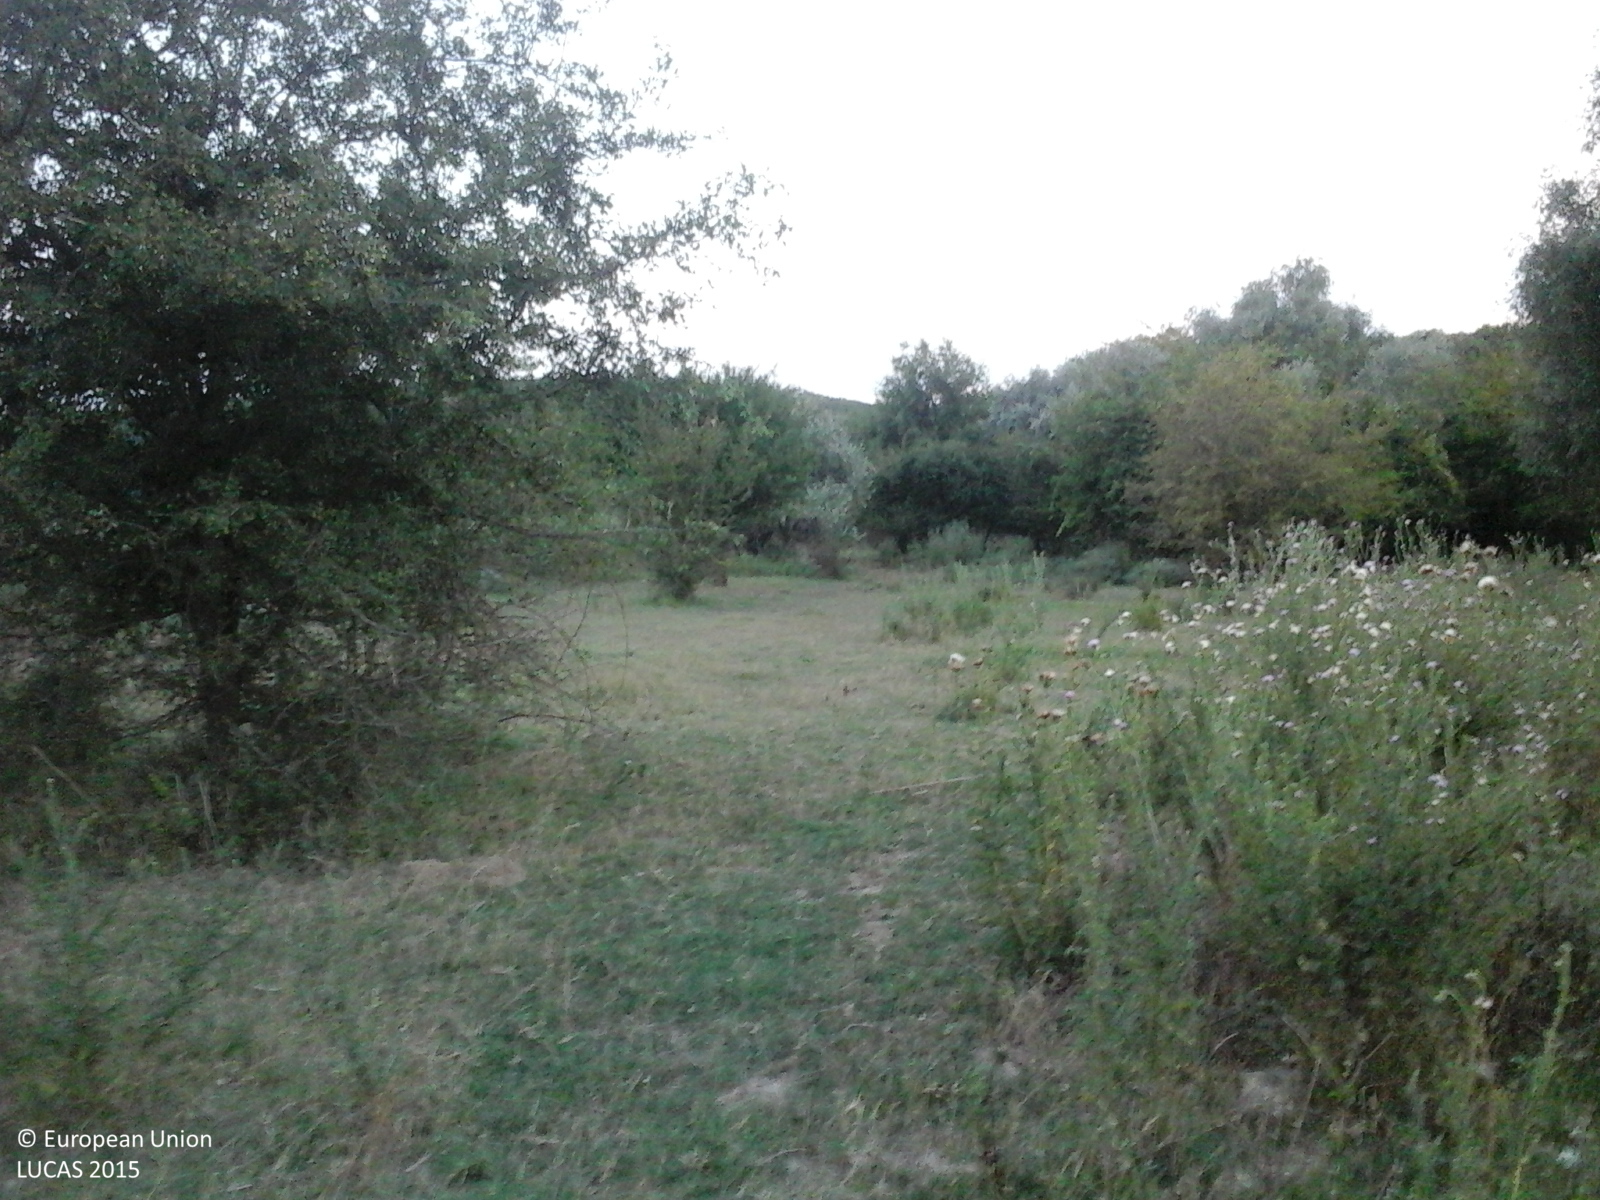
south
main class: Grassland
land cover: Spontaneously vegetated surfaces
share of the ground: > 75 %
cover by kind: herbaceous plants 100 %
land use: Semi-natural and natural areas not in use
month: August
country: RO
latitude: 44.3021
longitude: 28.0438
